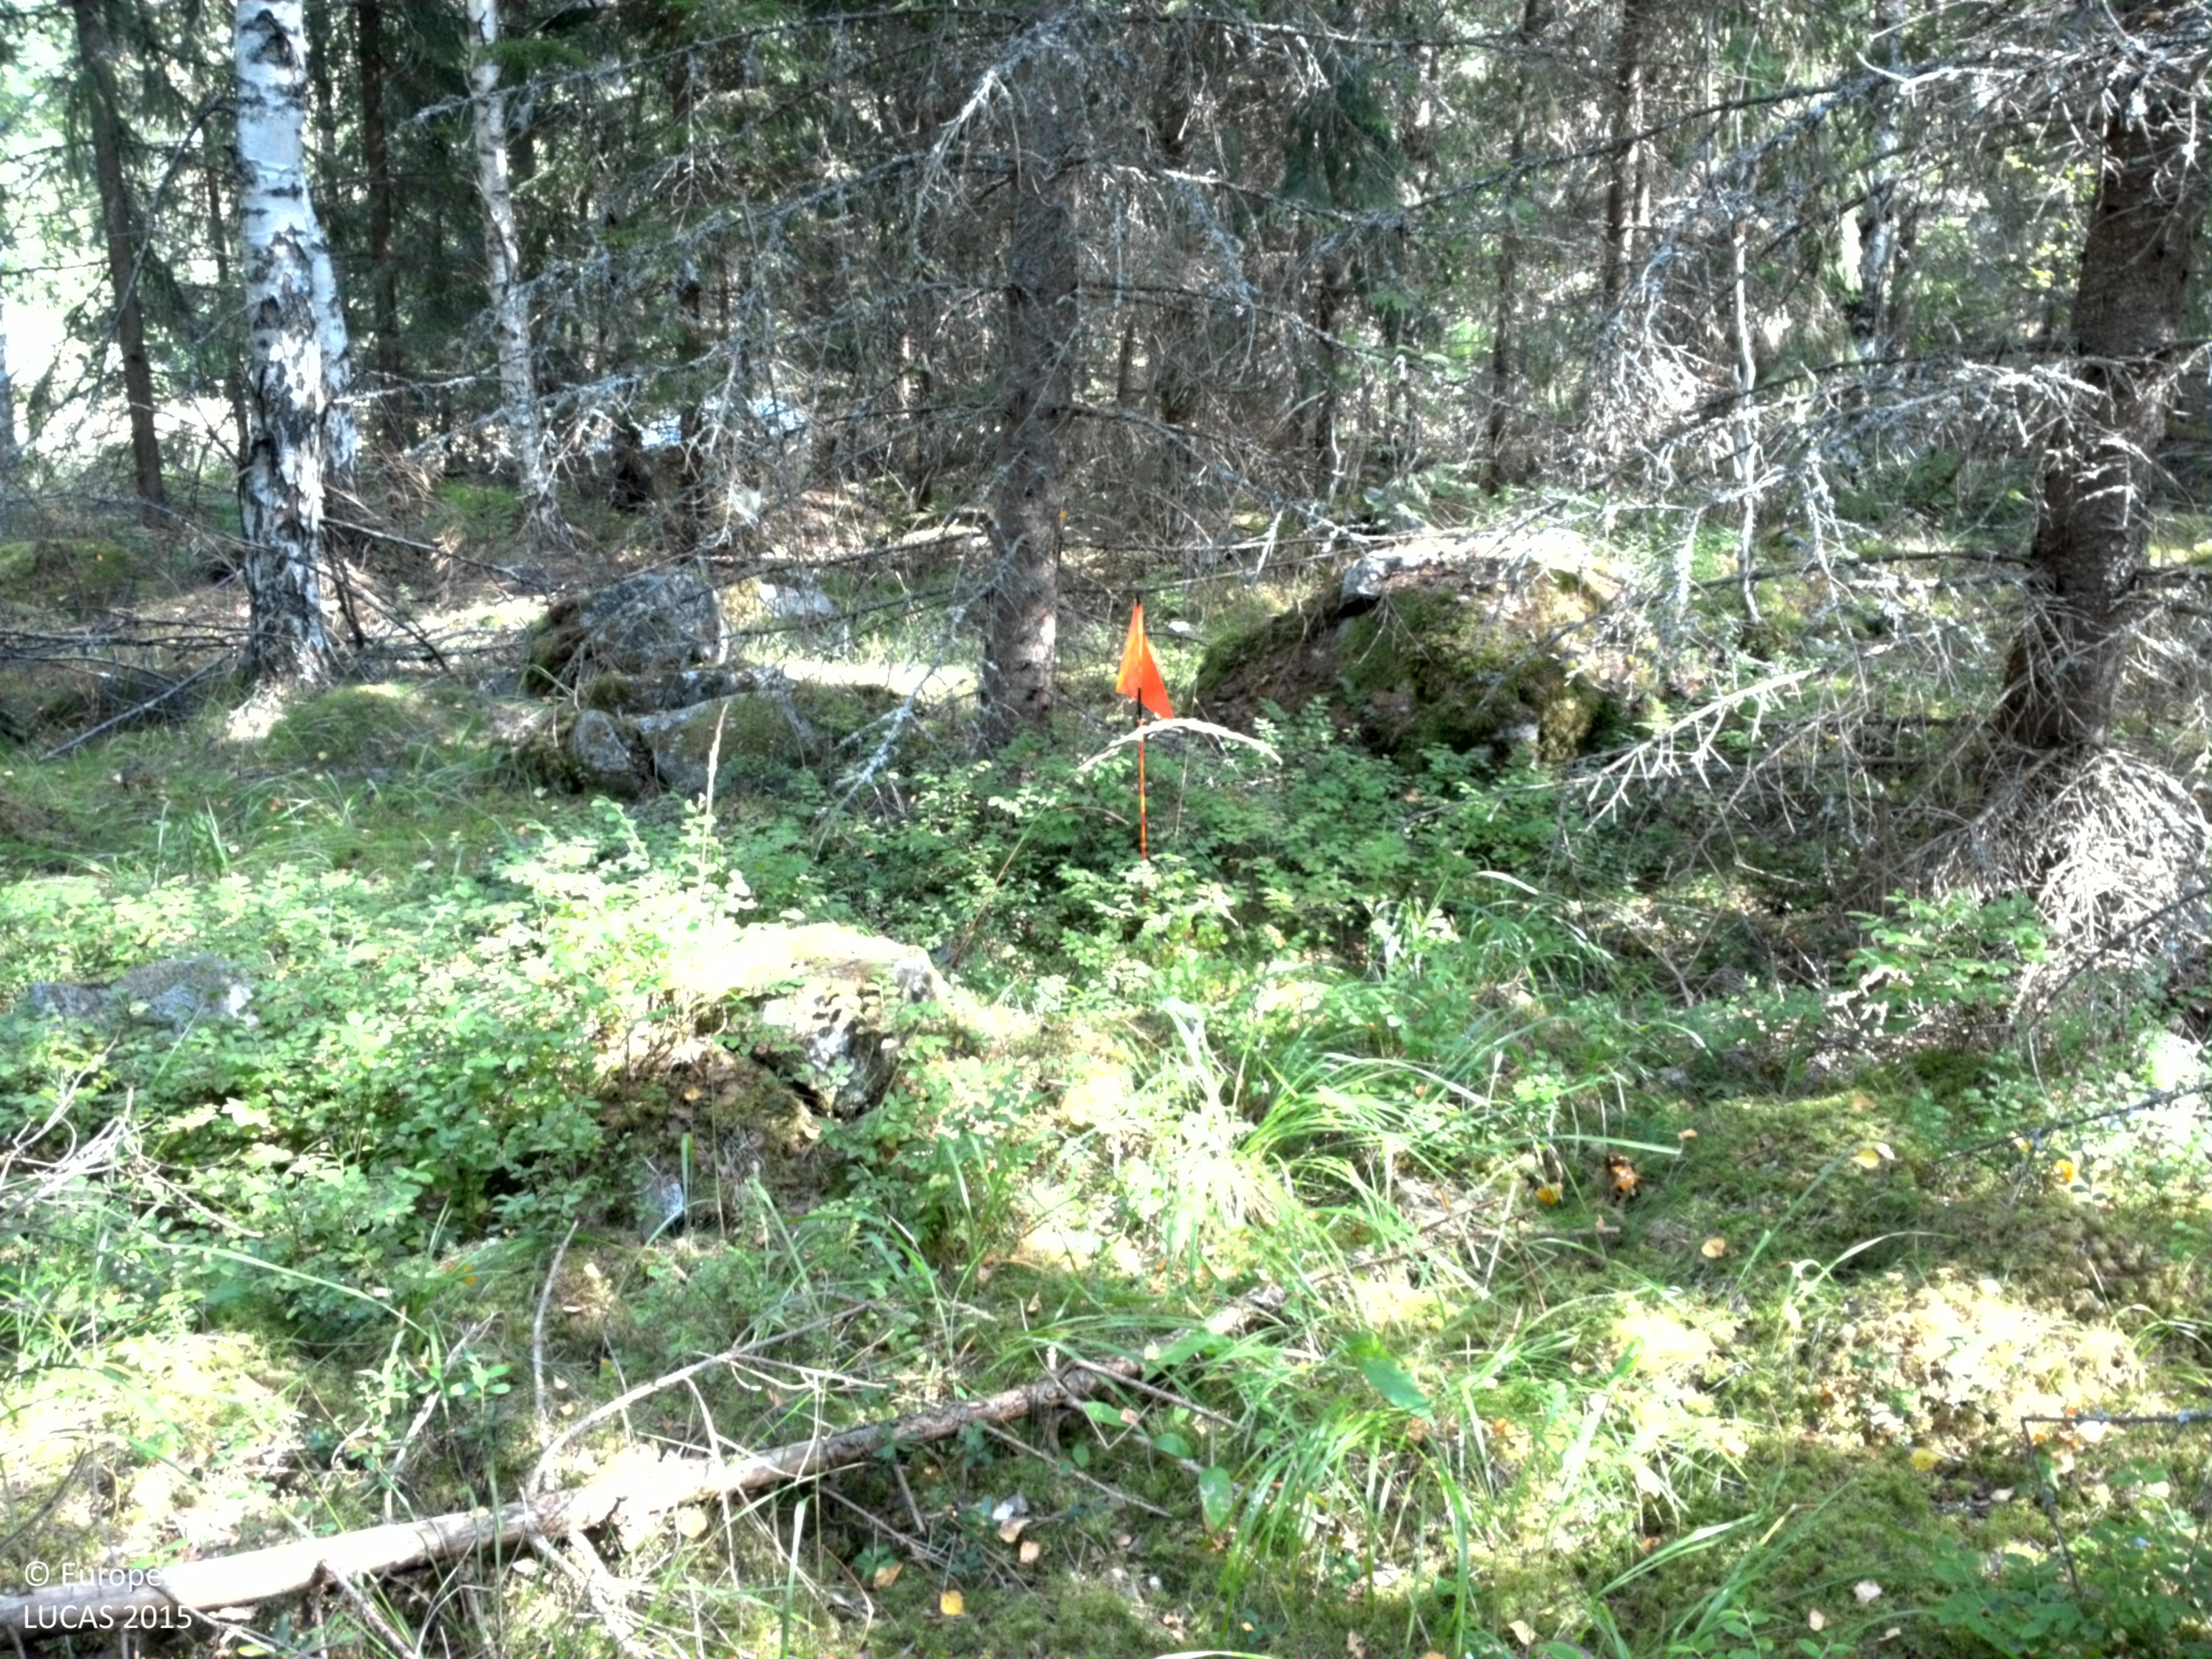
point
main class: Woodland
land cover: Spruce dominated coniferous woodland
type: boreal forest
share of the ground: > 75 %
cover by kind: coniferous forest trees 80 %, lichens and mosses 20 %
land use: Forestry
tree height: > 5 m
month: August
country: SE
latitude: 60.1123
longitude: 17.7478
